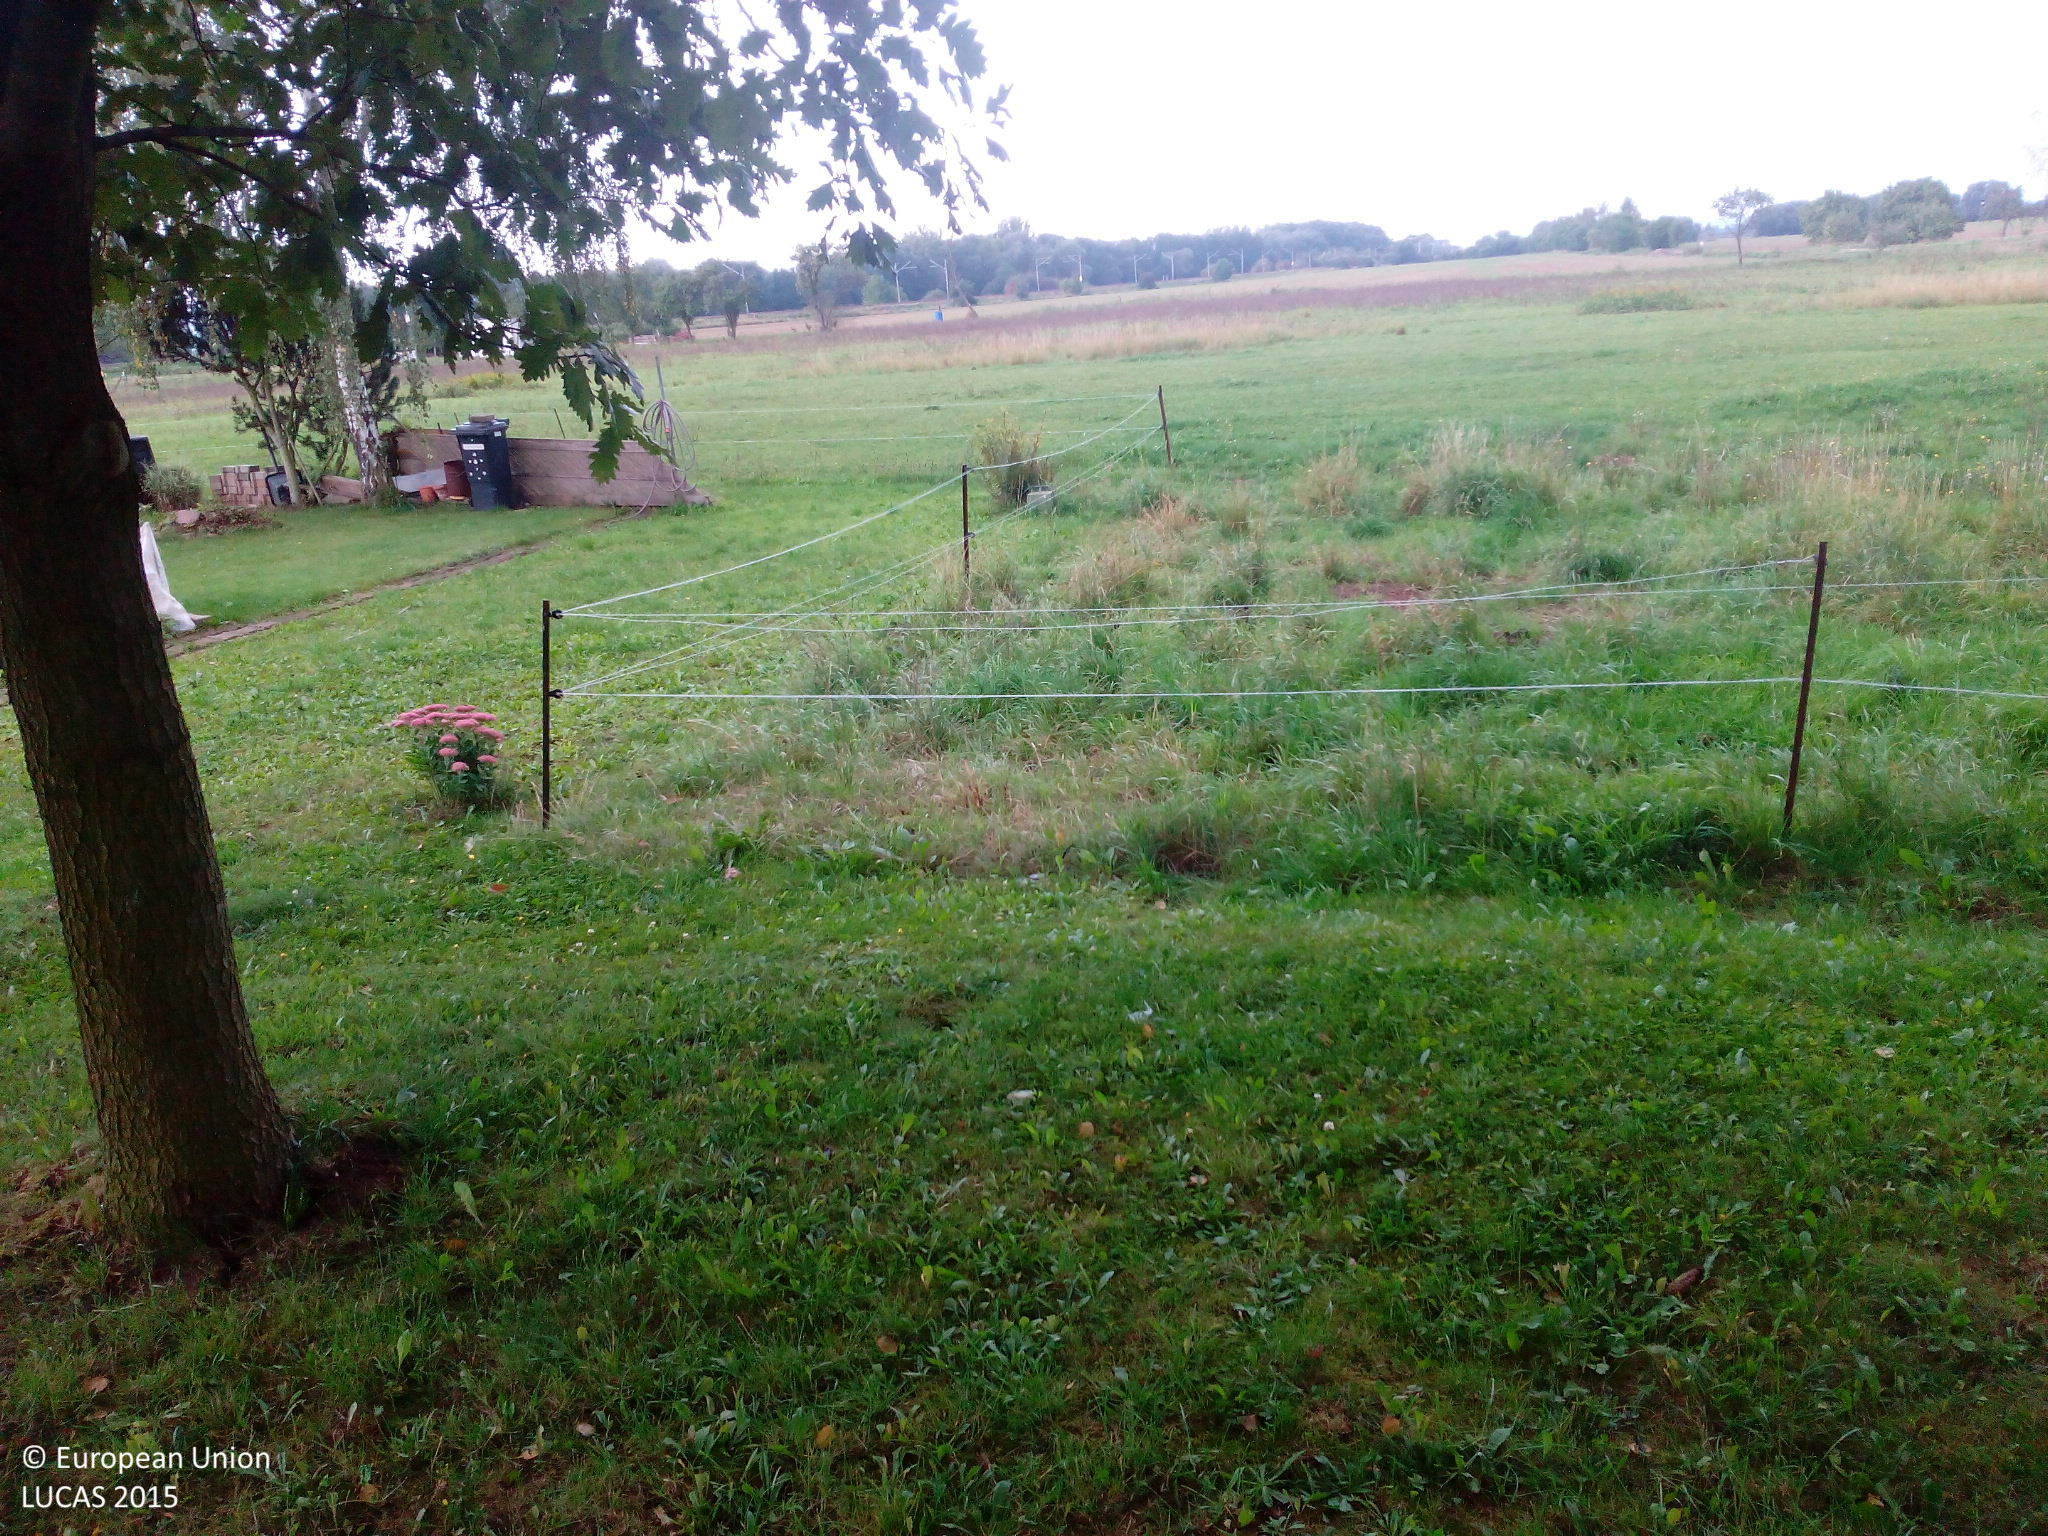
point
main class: Grassland
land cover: Grassland without tree/shrub cover
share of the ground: > 75 %
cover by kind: herbaceous plants 100 %
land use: Agriculture (excluding fallow land and kitchen gardens)
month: September
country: DE
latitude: 51.4570
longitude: 10.9352
